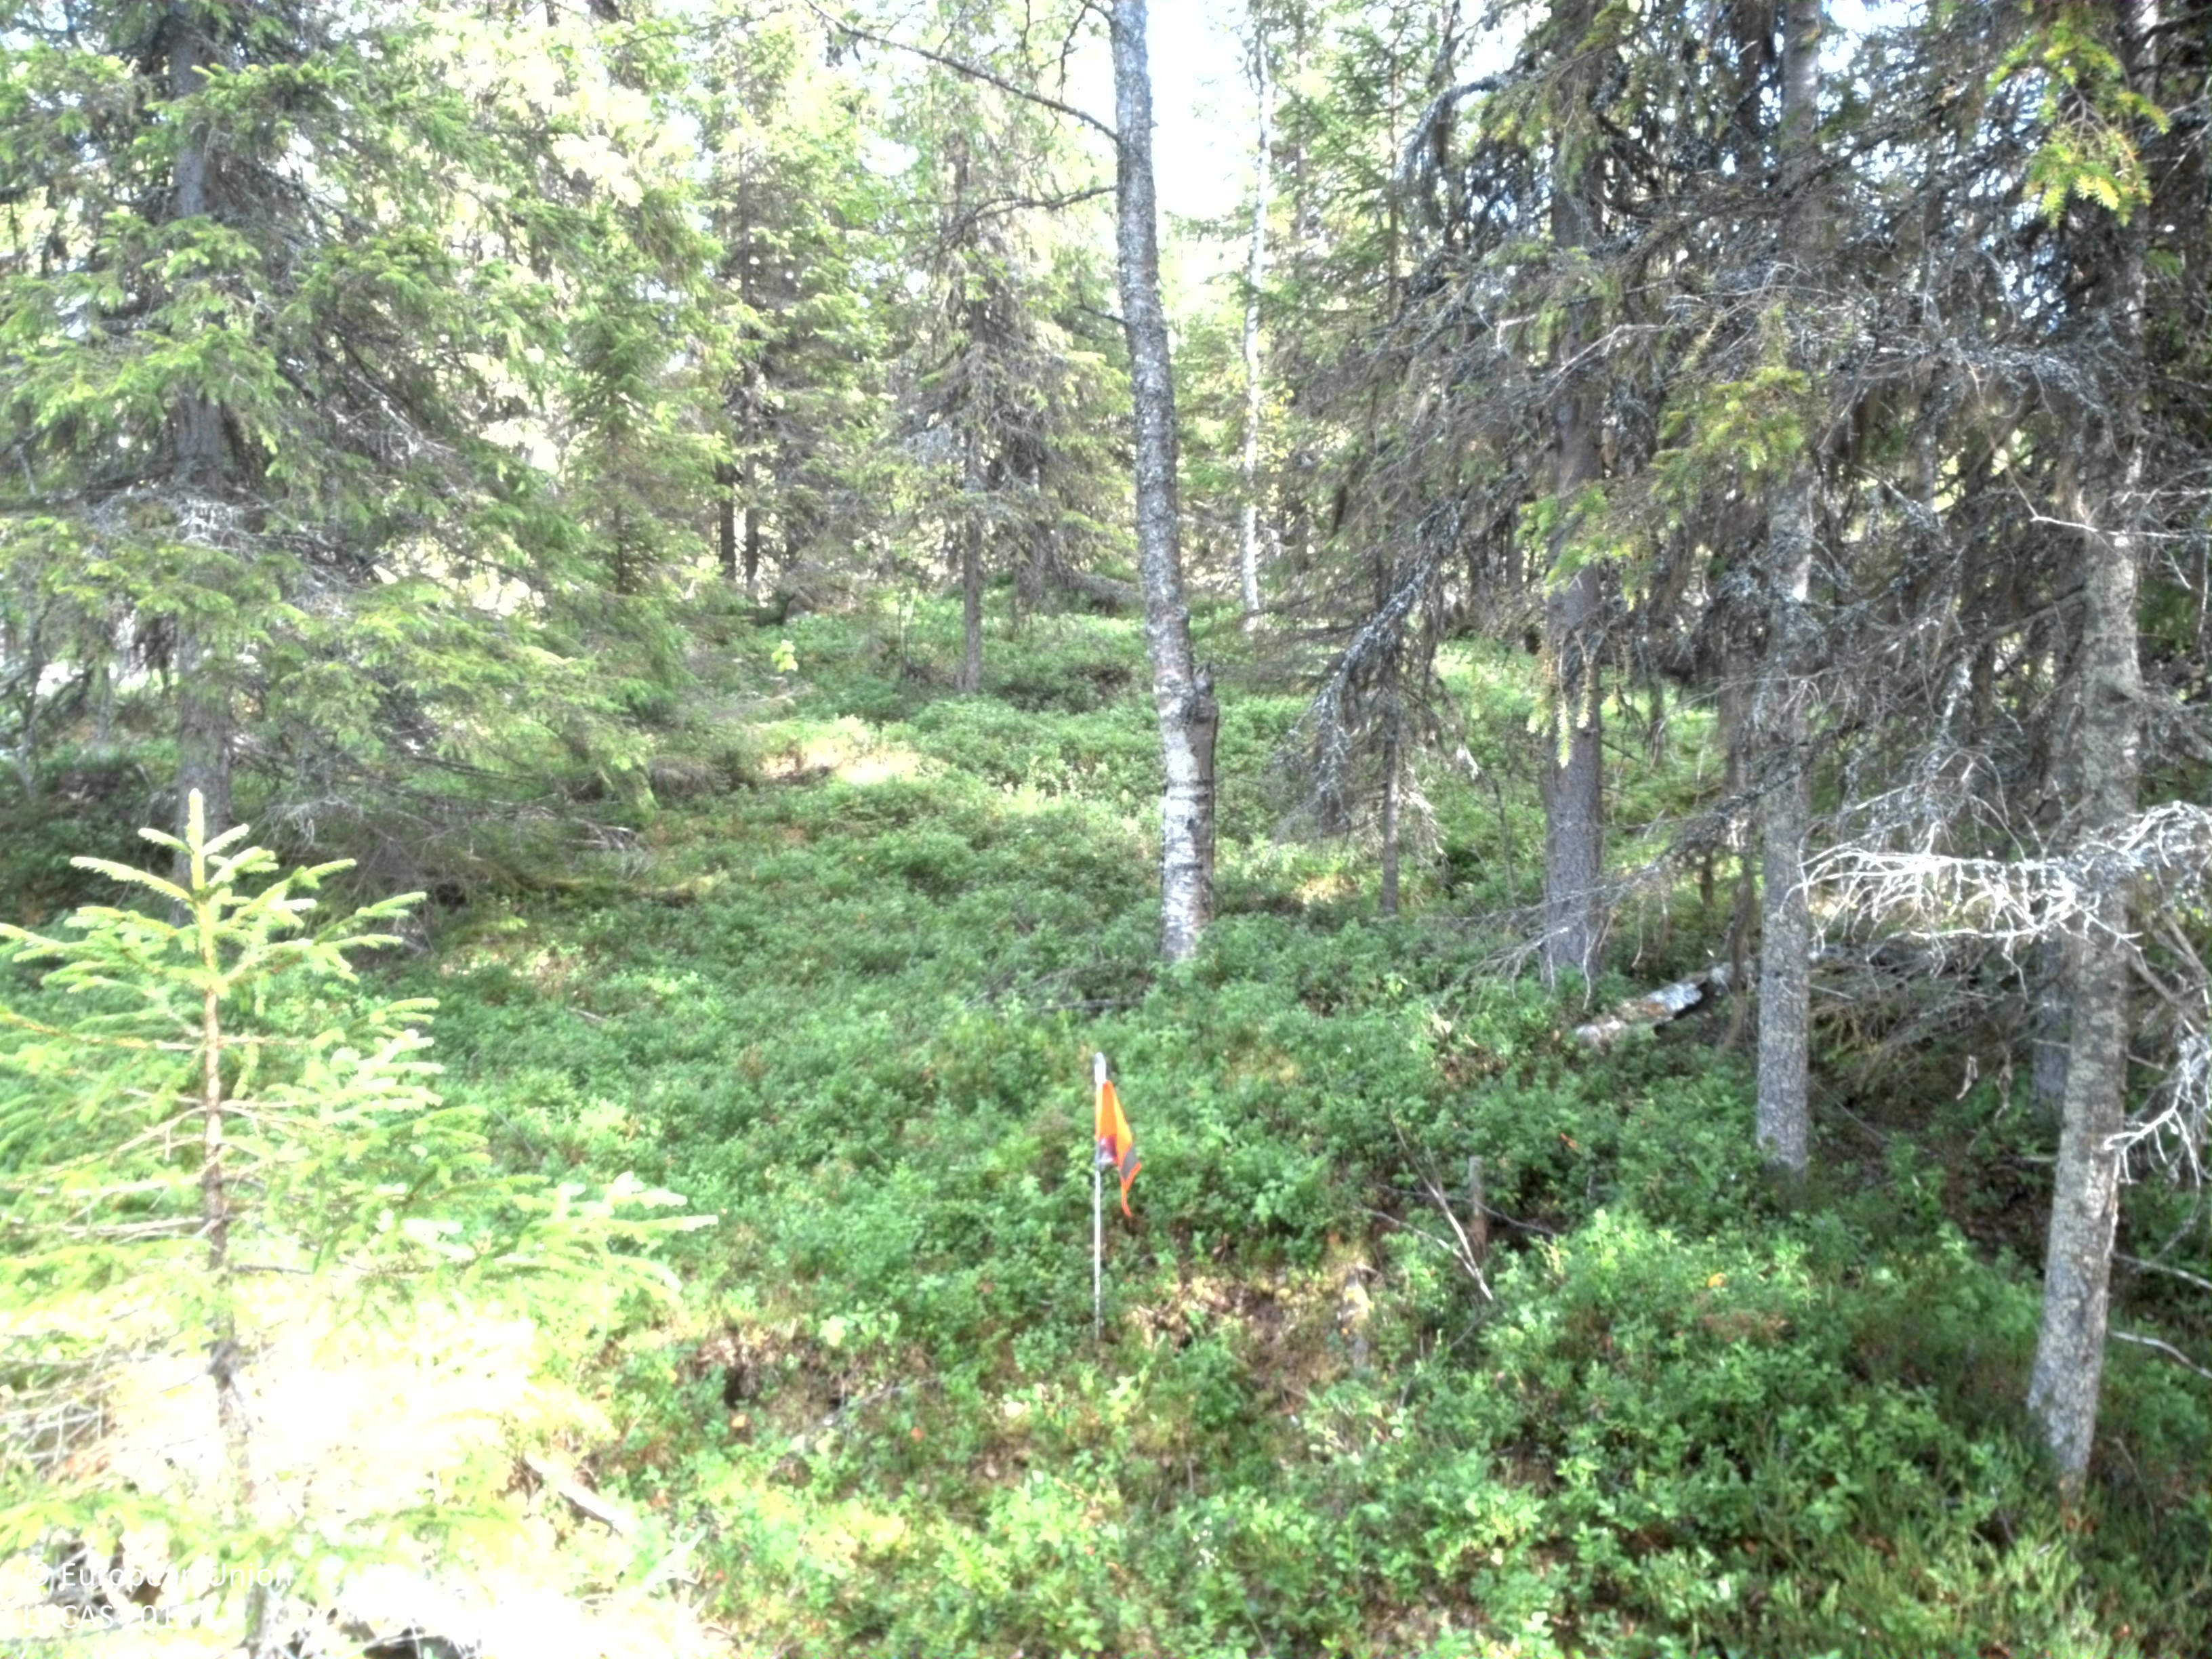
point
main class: Woodland
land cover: Spruce dominated mixed woodland
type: boreal forest
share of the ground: 25 - 50 %
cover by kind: coniferous forest trees 30 %, shrubs 30 %, broadleaved forest trees 20 %, lichens and mosses 15 %, herbaceous plants 5 %
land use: Forestry
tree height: > 5 m
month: September
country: SE
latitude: 65.3475
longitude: 16.1728
